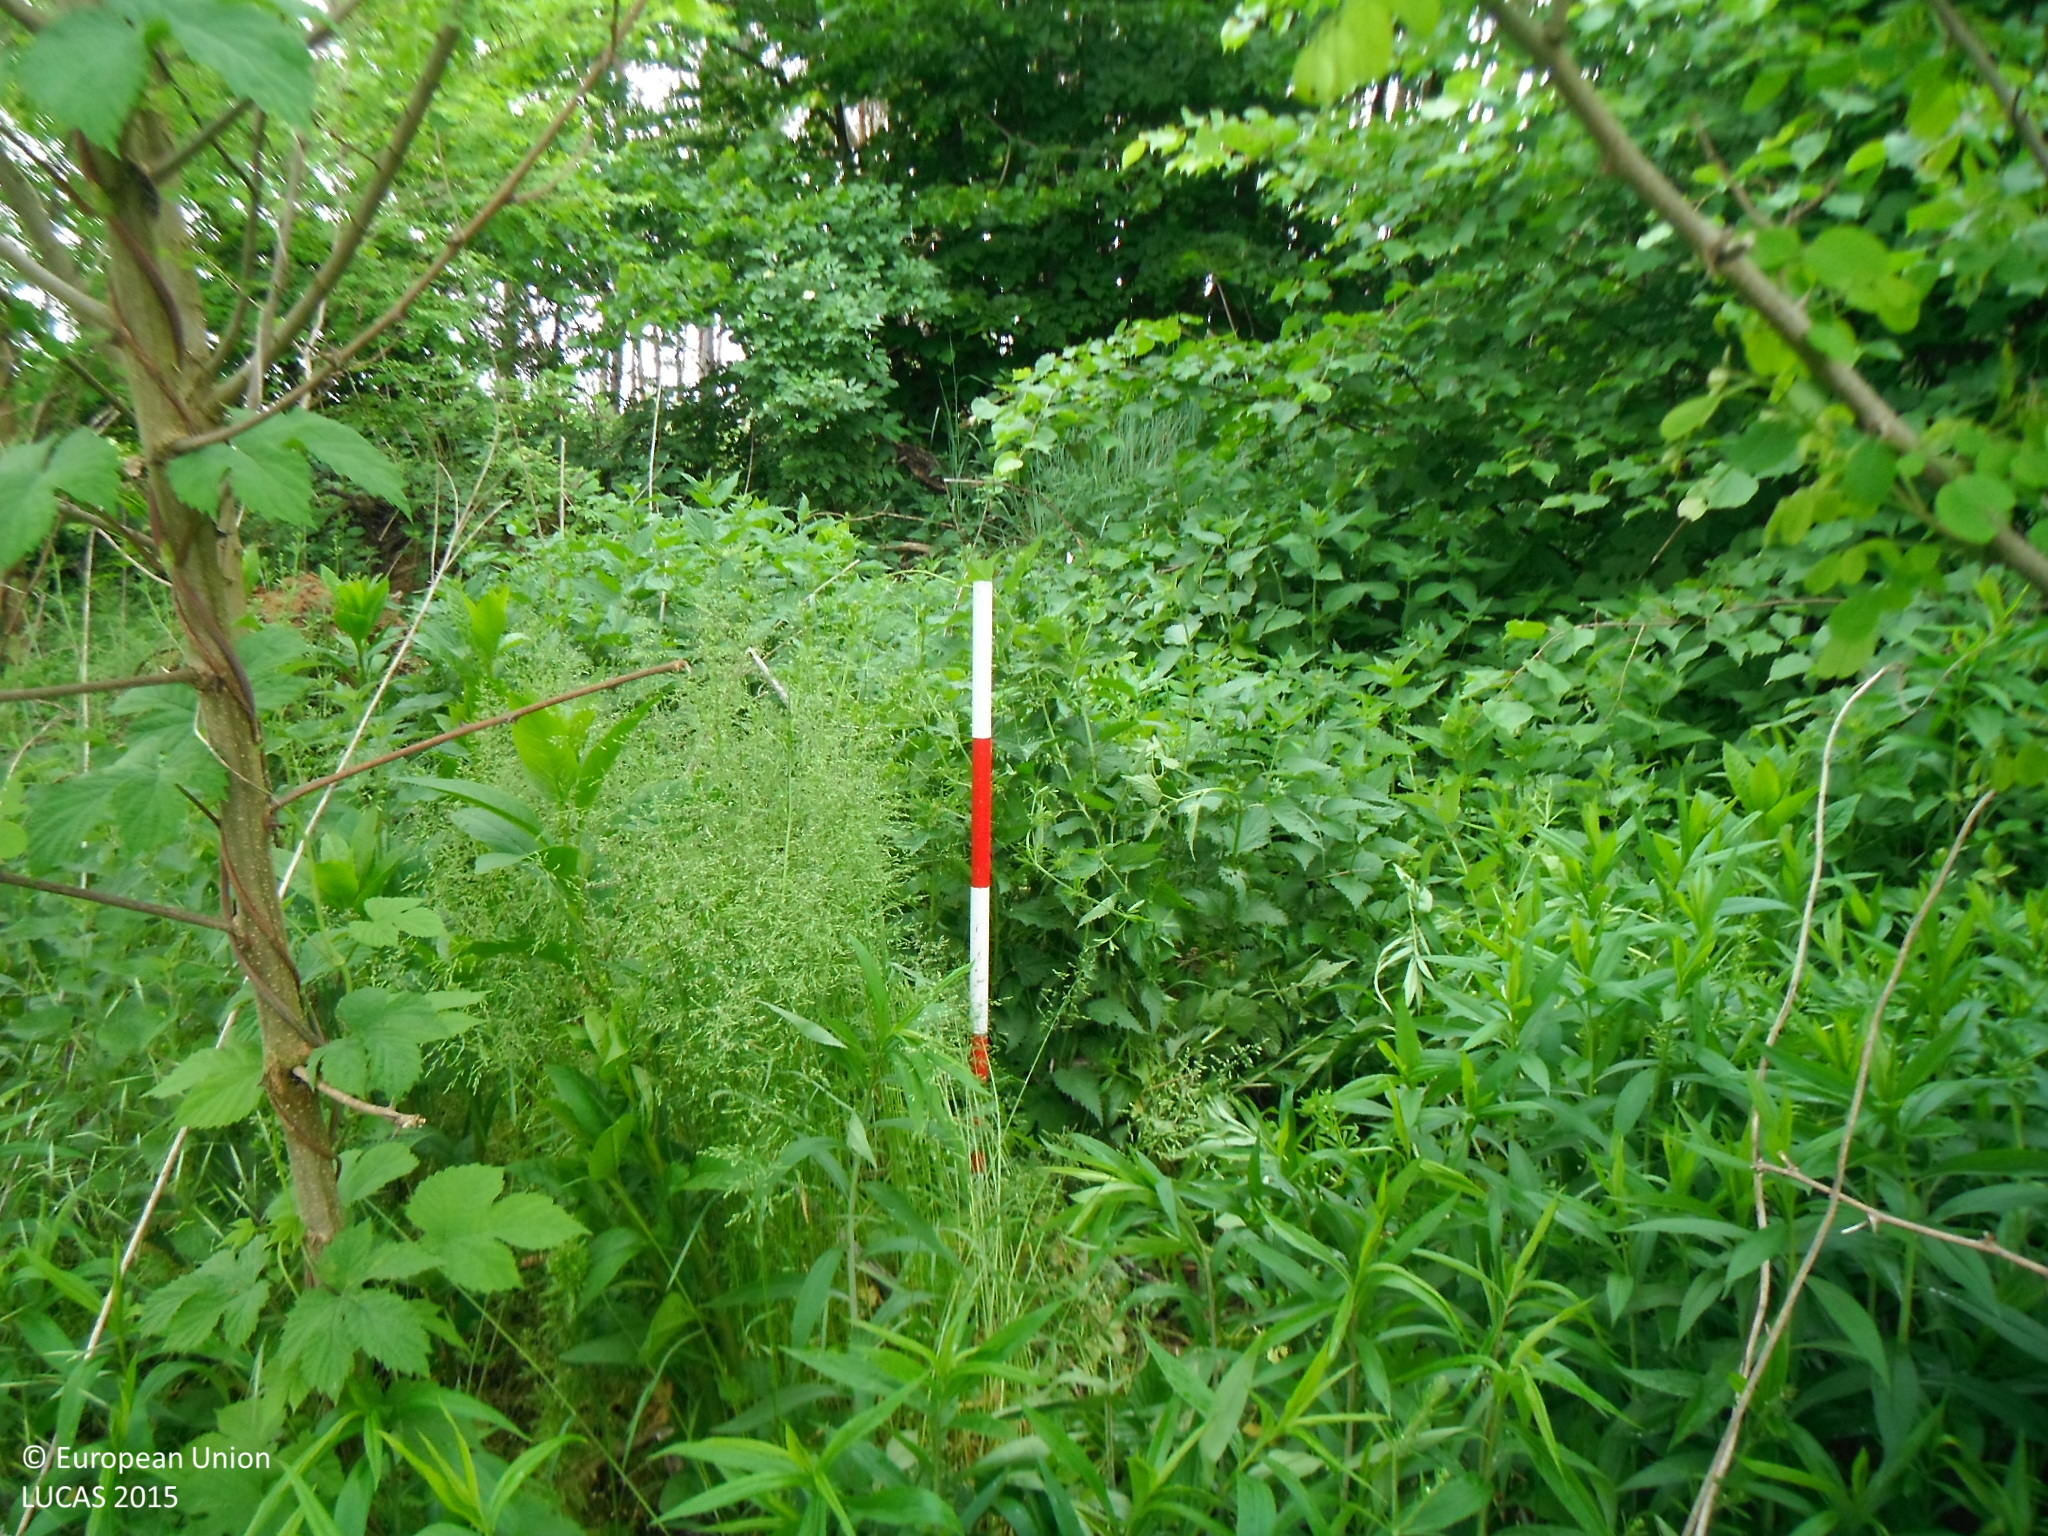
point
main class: Shrubland
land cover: Shrubland with sparse tree cover
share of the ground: > 75 %
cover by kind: herbaceous plants 80 %, shrubs 15 %, broadleaved forest trees 5 %
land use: Abandoned areas
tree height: < 5 m
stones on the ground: < 10 %
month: May
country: SK
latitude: 48.3971
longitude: 17.0178
